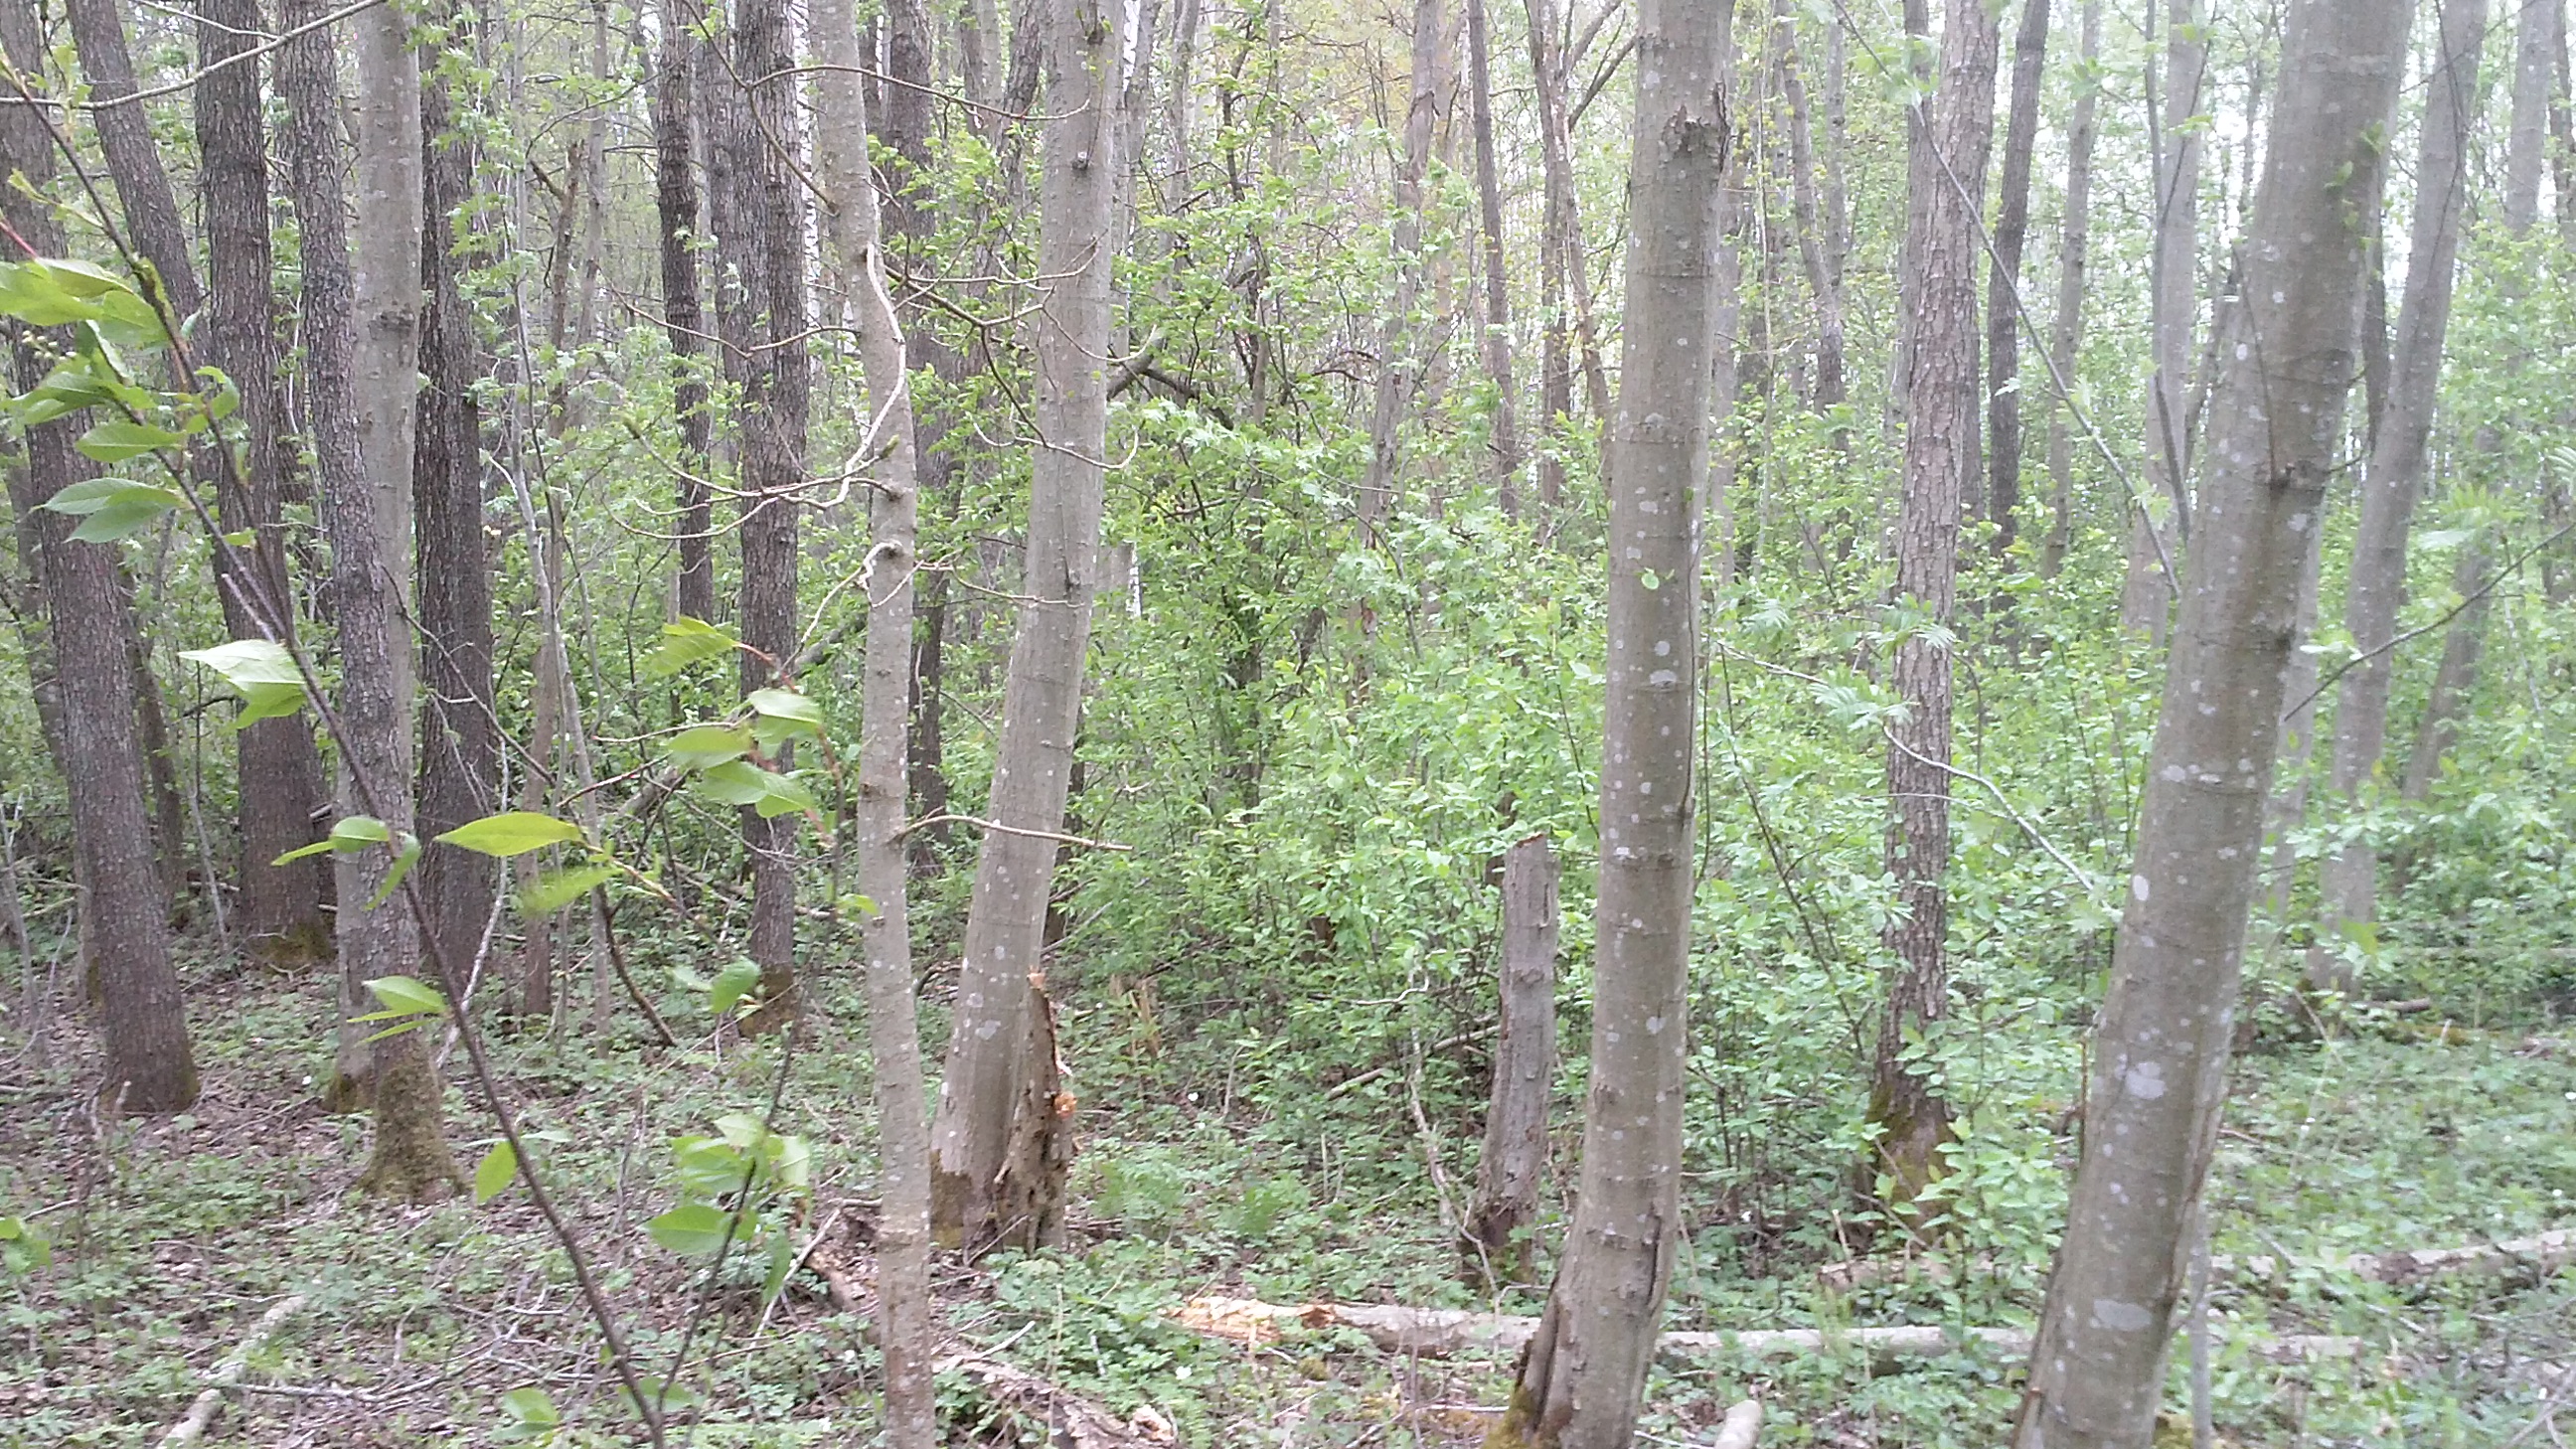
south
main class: Woodland
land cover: Broadleaved woodland
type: non-riverine alder, birch or aspen forest
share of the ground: > 75 %
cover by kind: broadleaved forest trees 90 %, shrubs 10 %
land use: Forestry
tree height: > 5 m
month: May
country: LV
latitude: 55.9706
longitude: 27.0716
